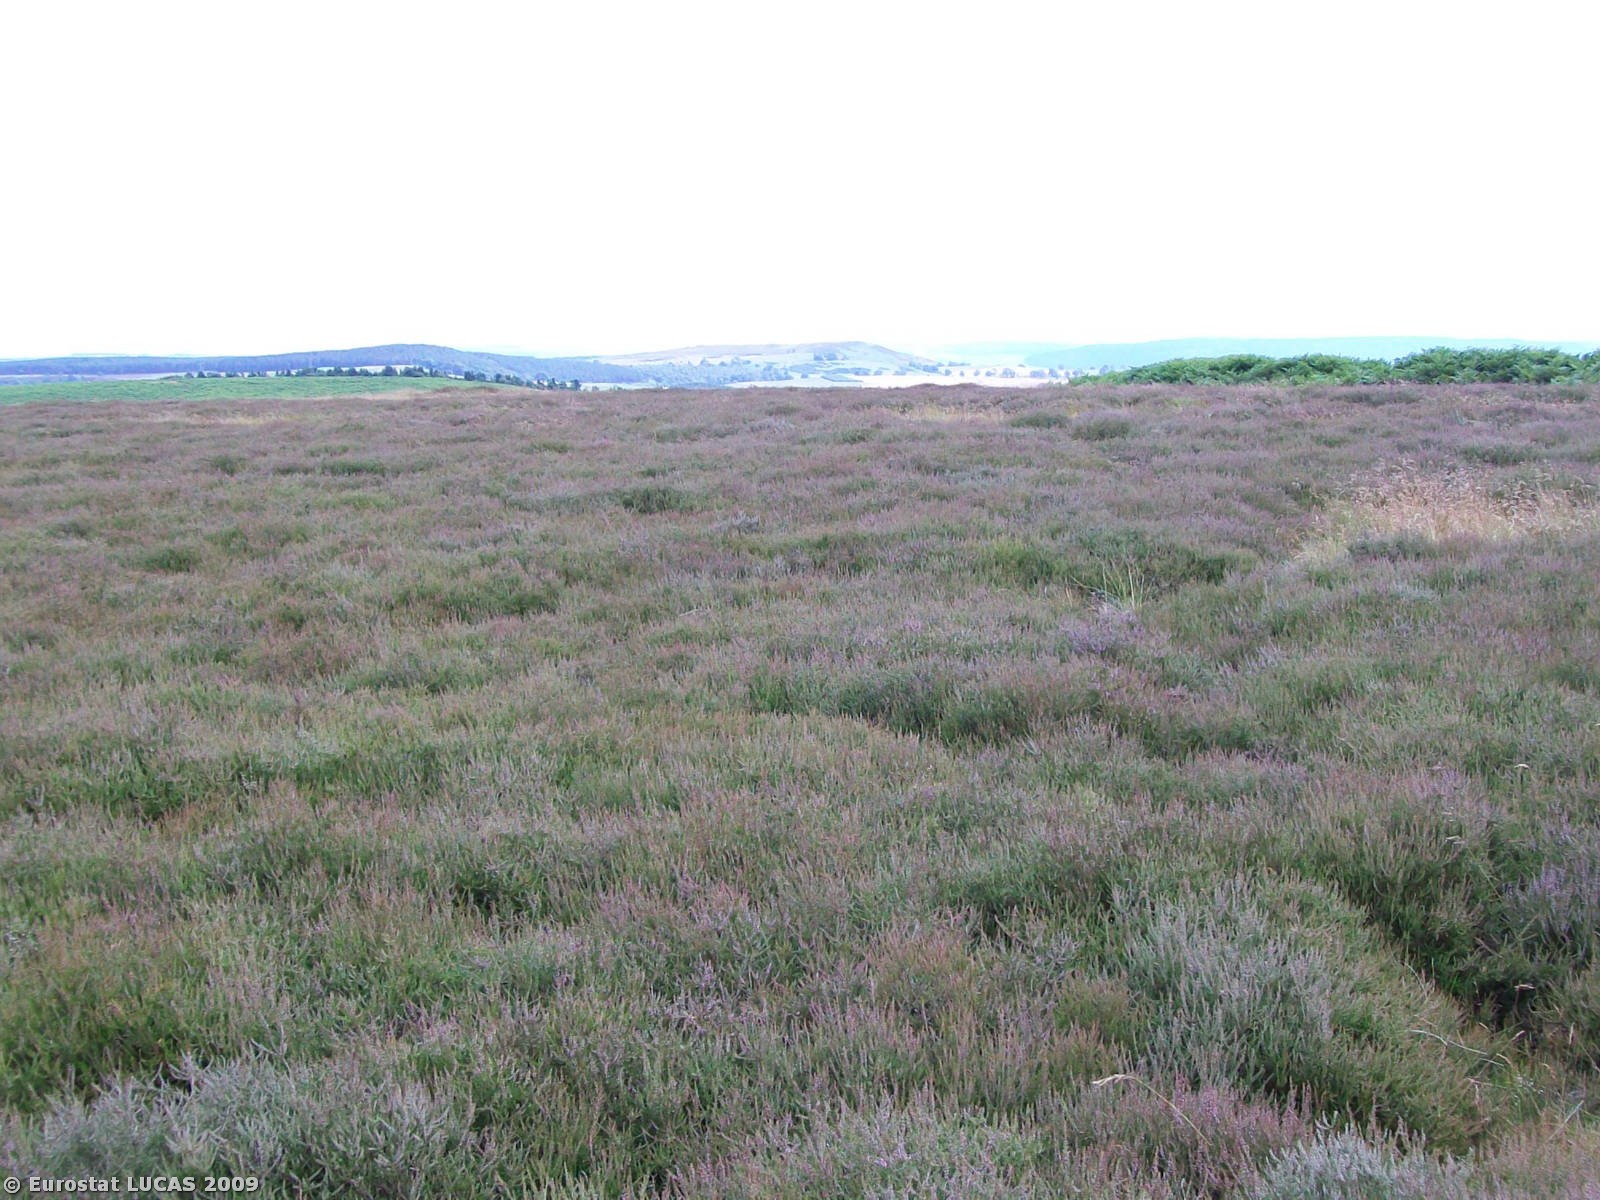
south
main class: Shrubland
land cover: Shrubland without tree cover
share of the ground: > 75 %
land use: Agriculture (excluding fallow land and kitchen gardens)
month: July
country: GB
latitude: 55.4886
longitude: -1.8733
